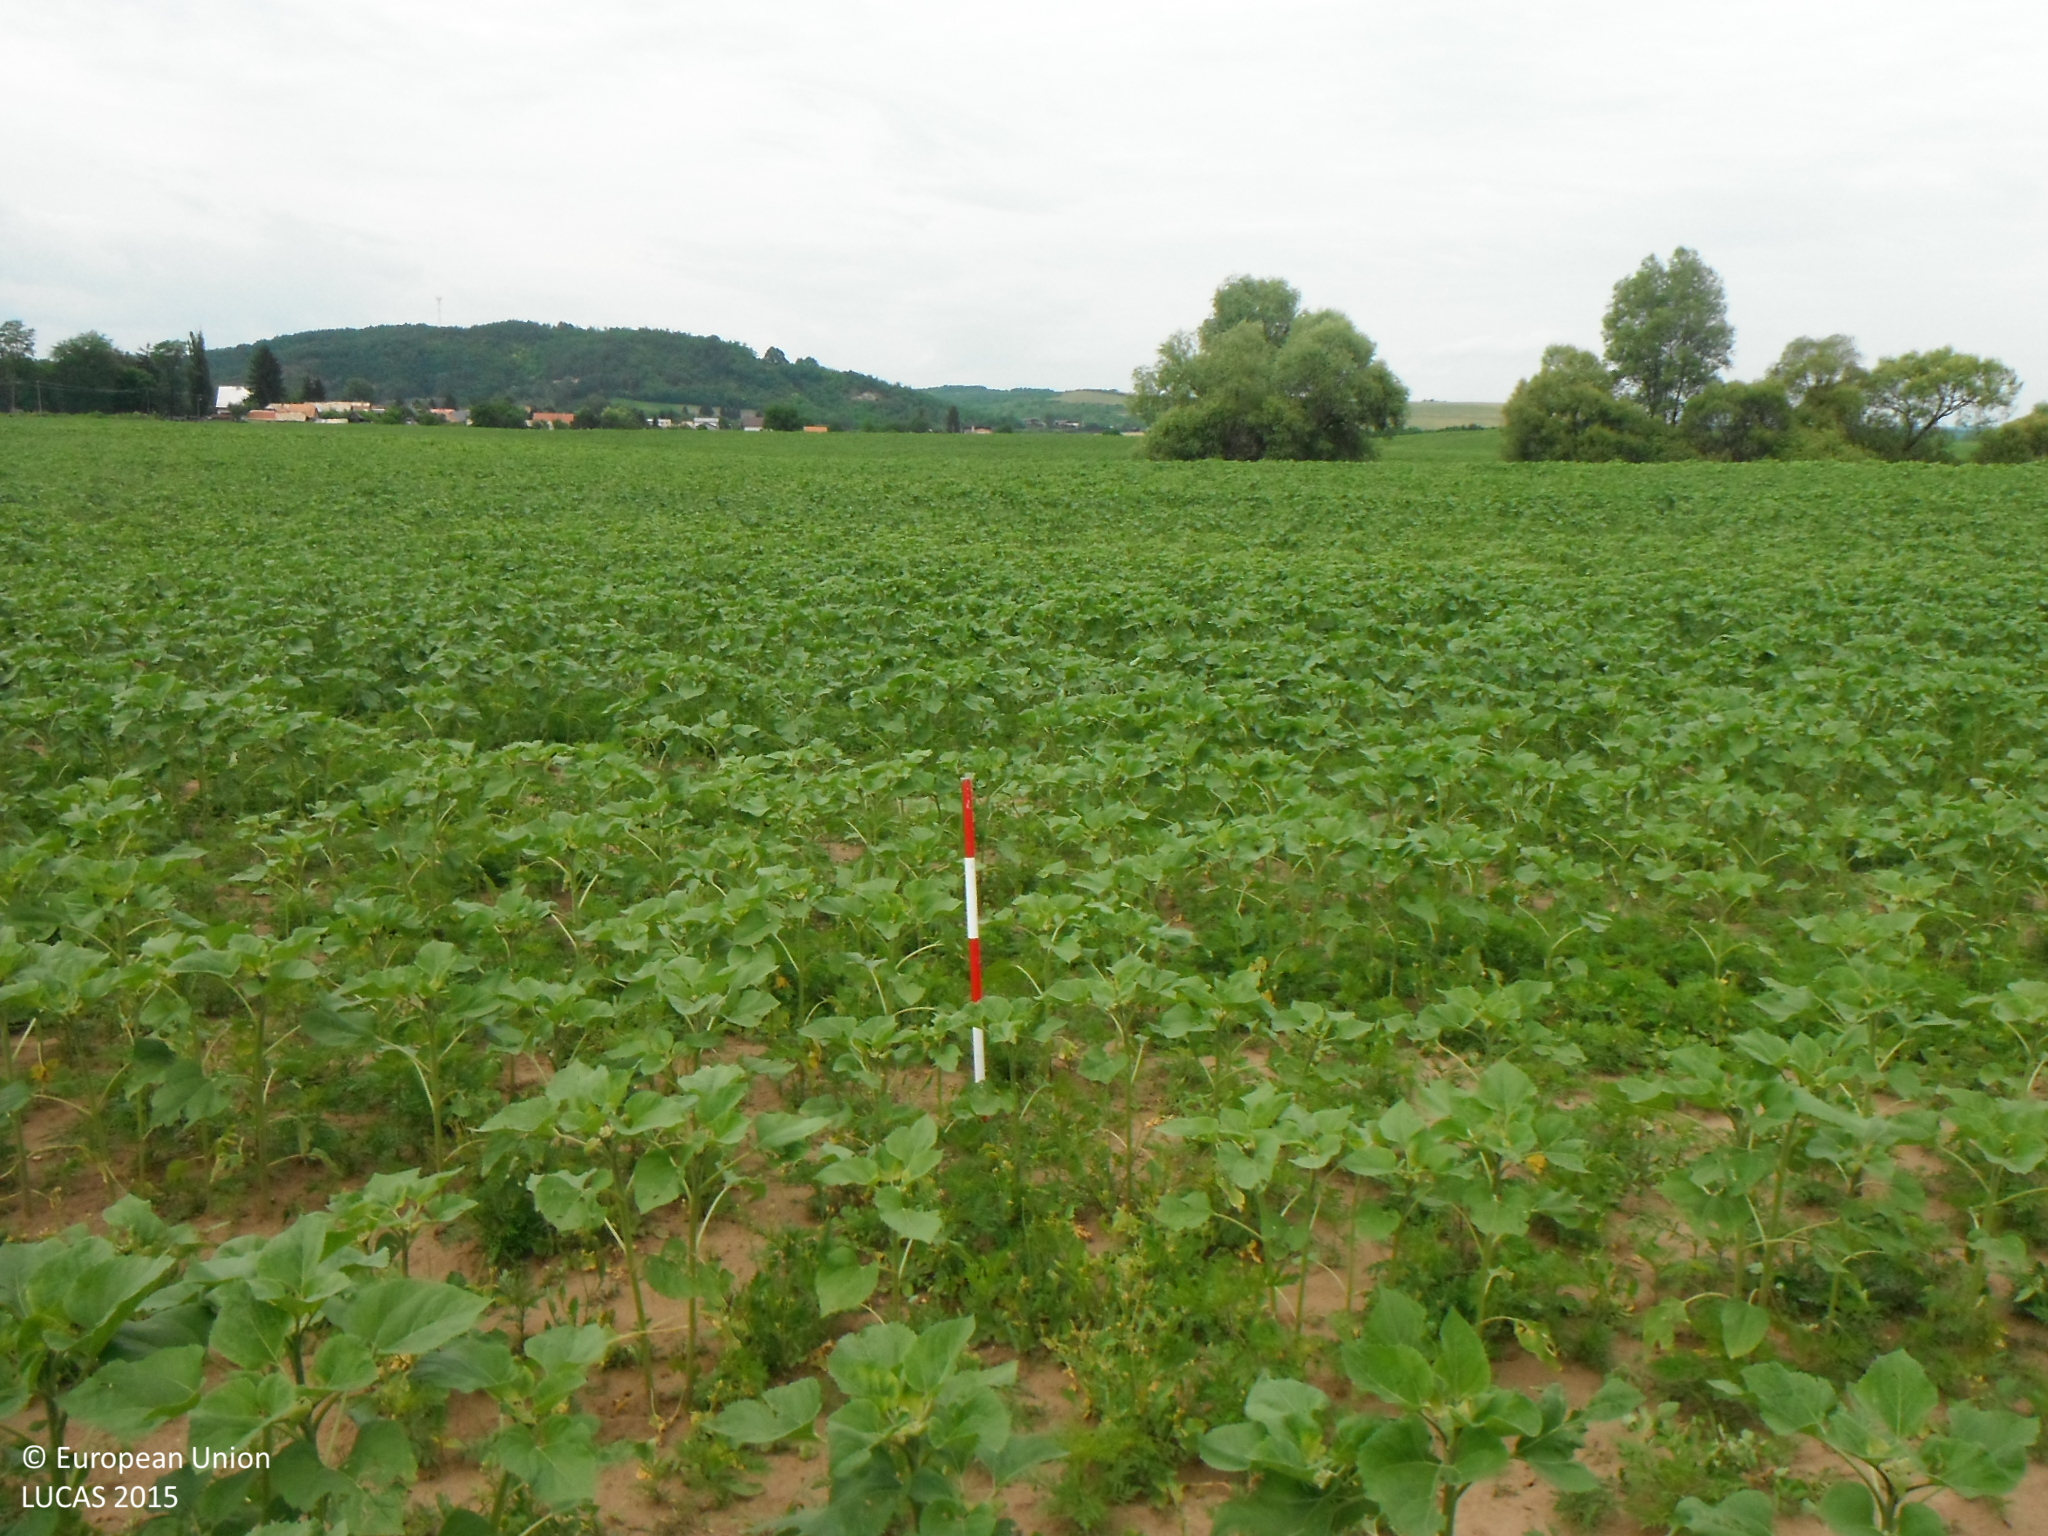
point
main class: Cropland
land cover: Sunflower
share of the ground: 50 - 75 %
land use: Agriculture (excluding fallow land and kitchen gardens)
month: June
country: SK
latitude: 48.0876
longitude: 19.4612
